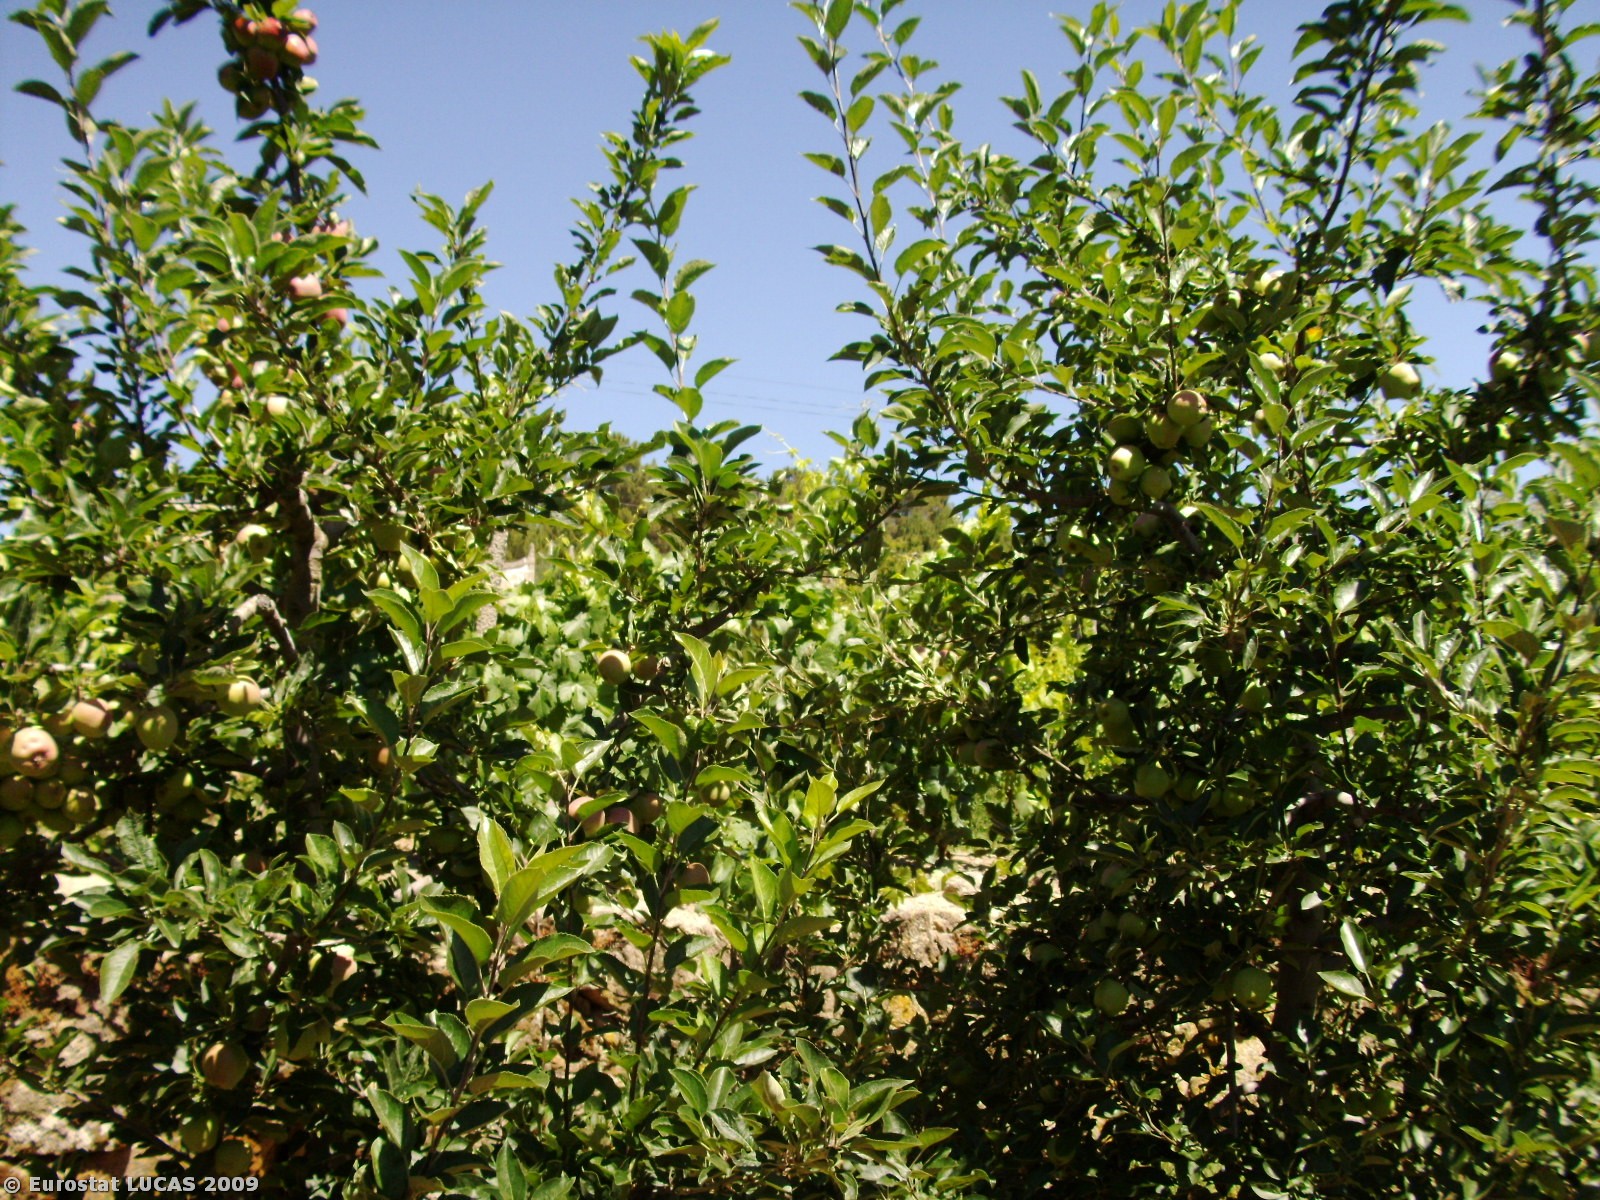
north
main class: Cropland
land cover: Apple fruit
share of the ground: > 75 %
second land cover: Spontaneously vegetated surfaces
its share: 10 - 25 %
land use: Agriculture (excluding fallow land and kitchen gardens)
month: July
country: PT
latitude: 41.0007
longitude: -7.7324
